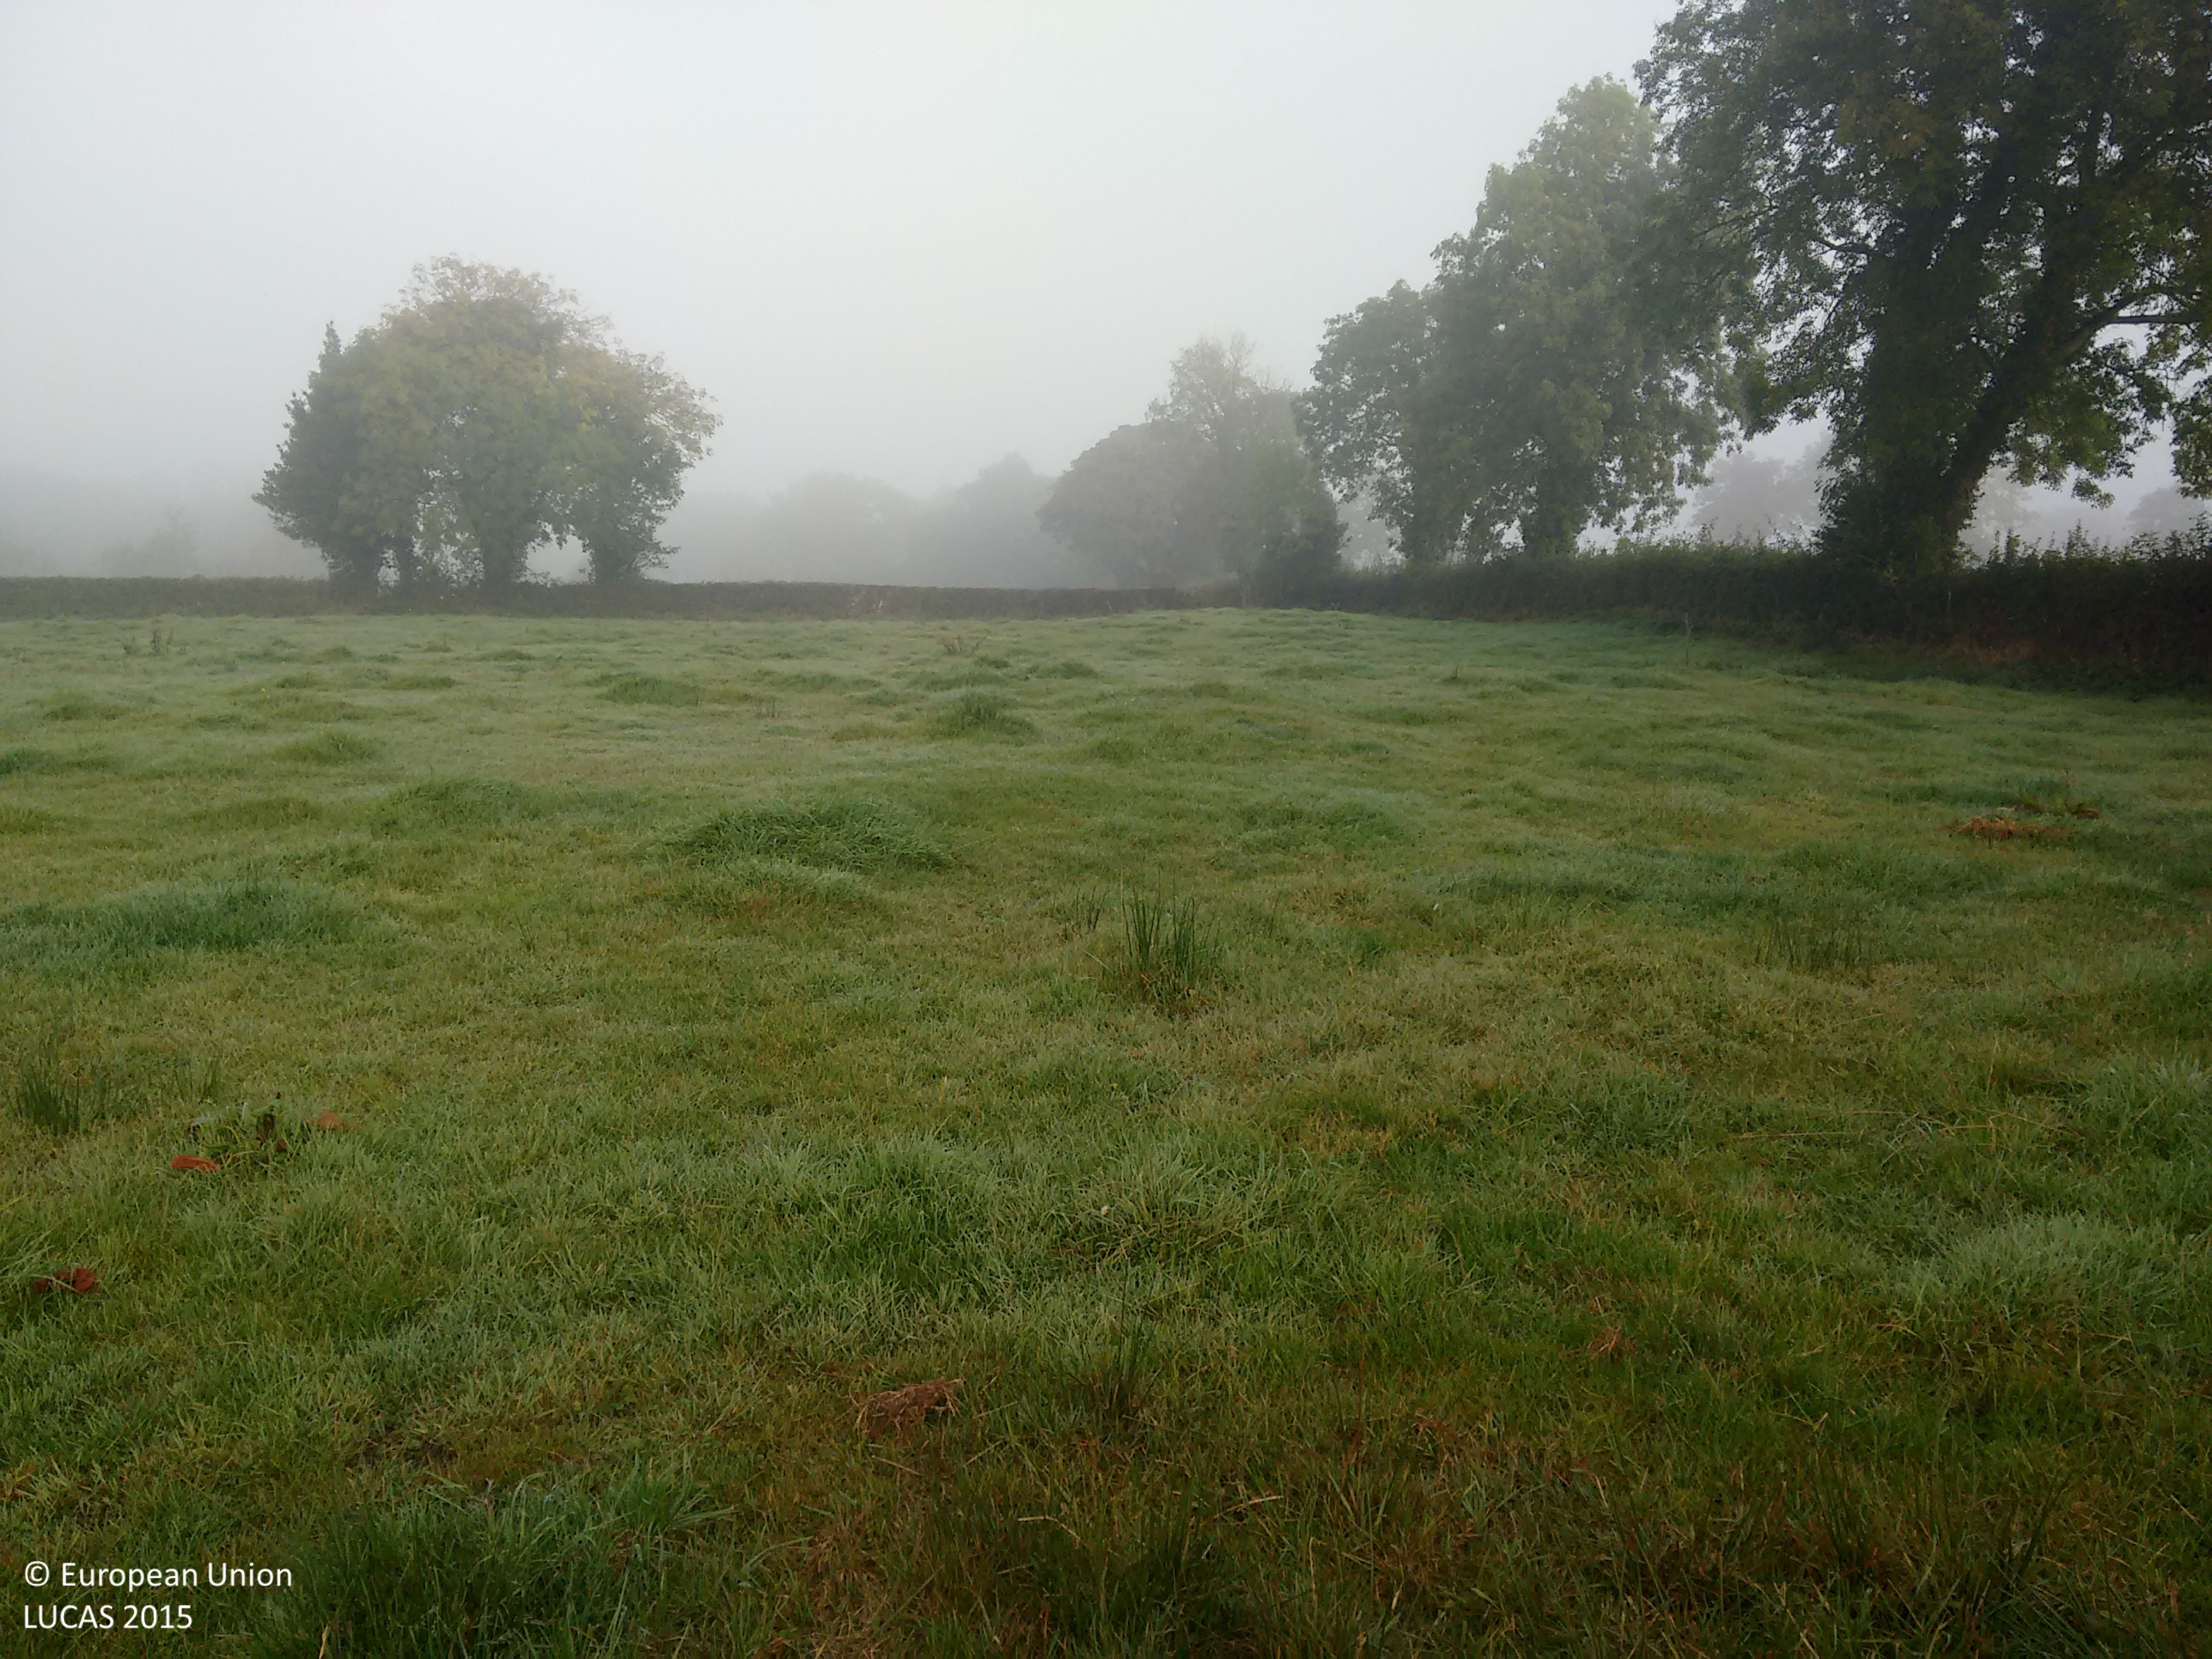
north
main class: Grassland
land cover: Grassland without tree/shrub cover
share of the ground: > 75 %
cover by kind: herbaceous plants 100 %
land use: Agriculture (excluding fallow land and kitchen gardens)
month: October
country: GB
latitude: 54.2878
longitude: -7.7543
